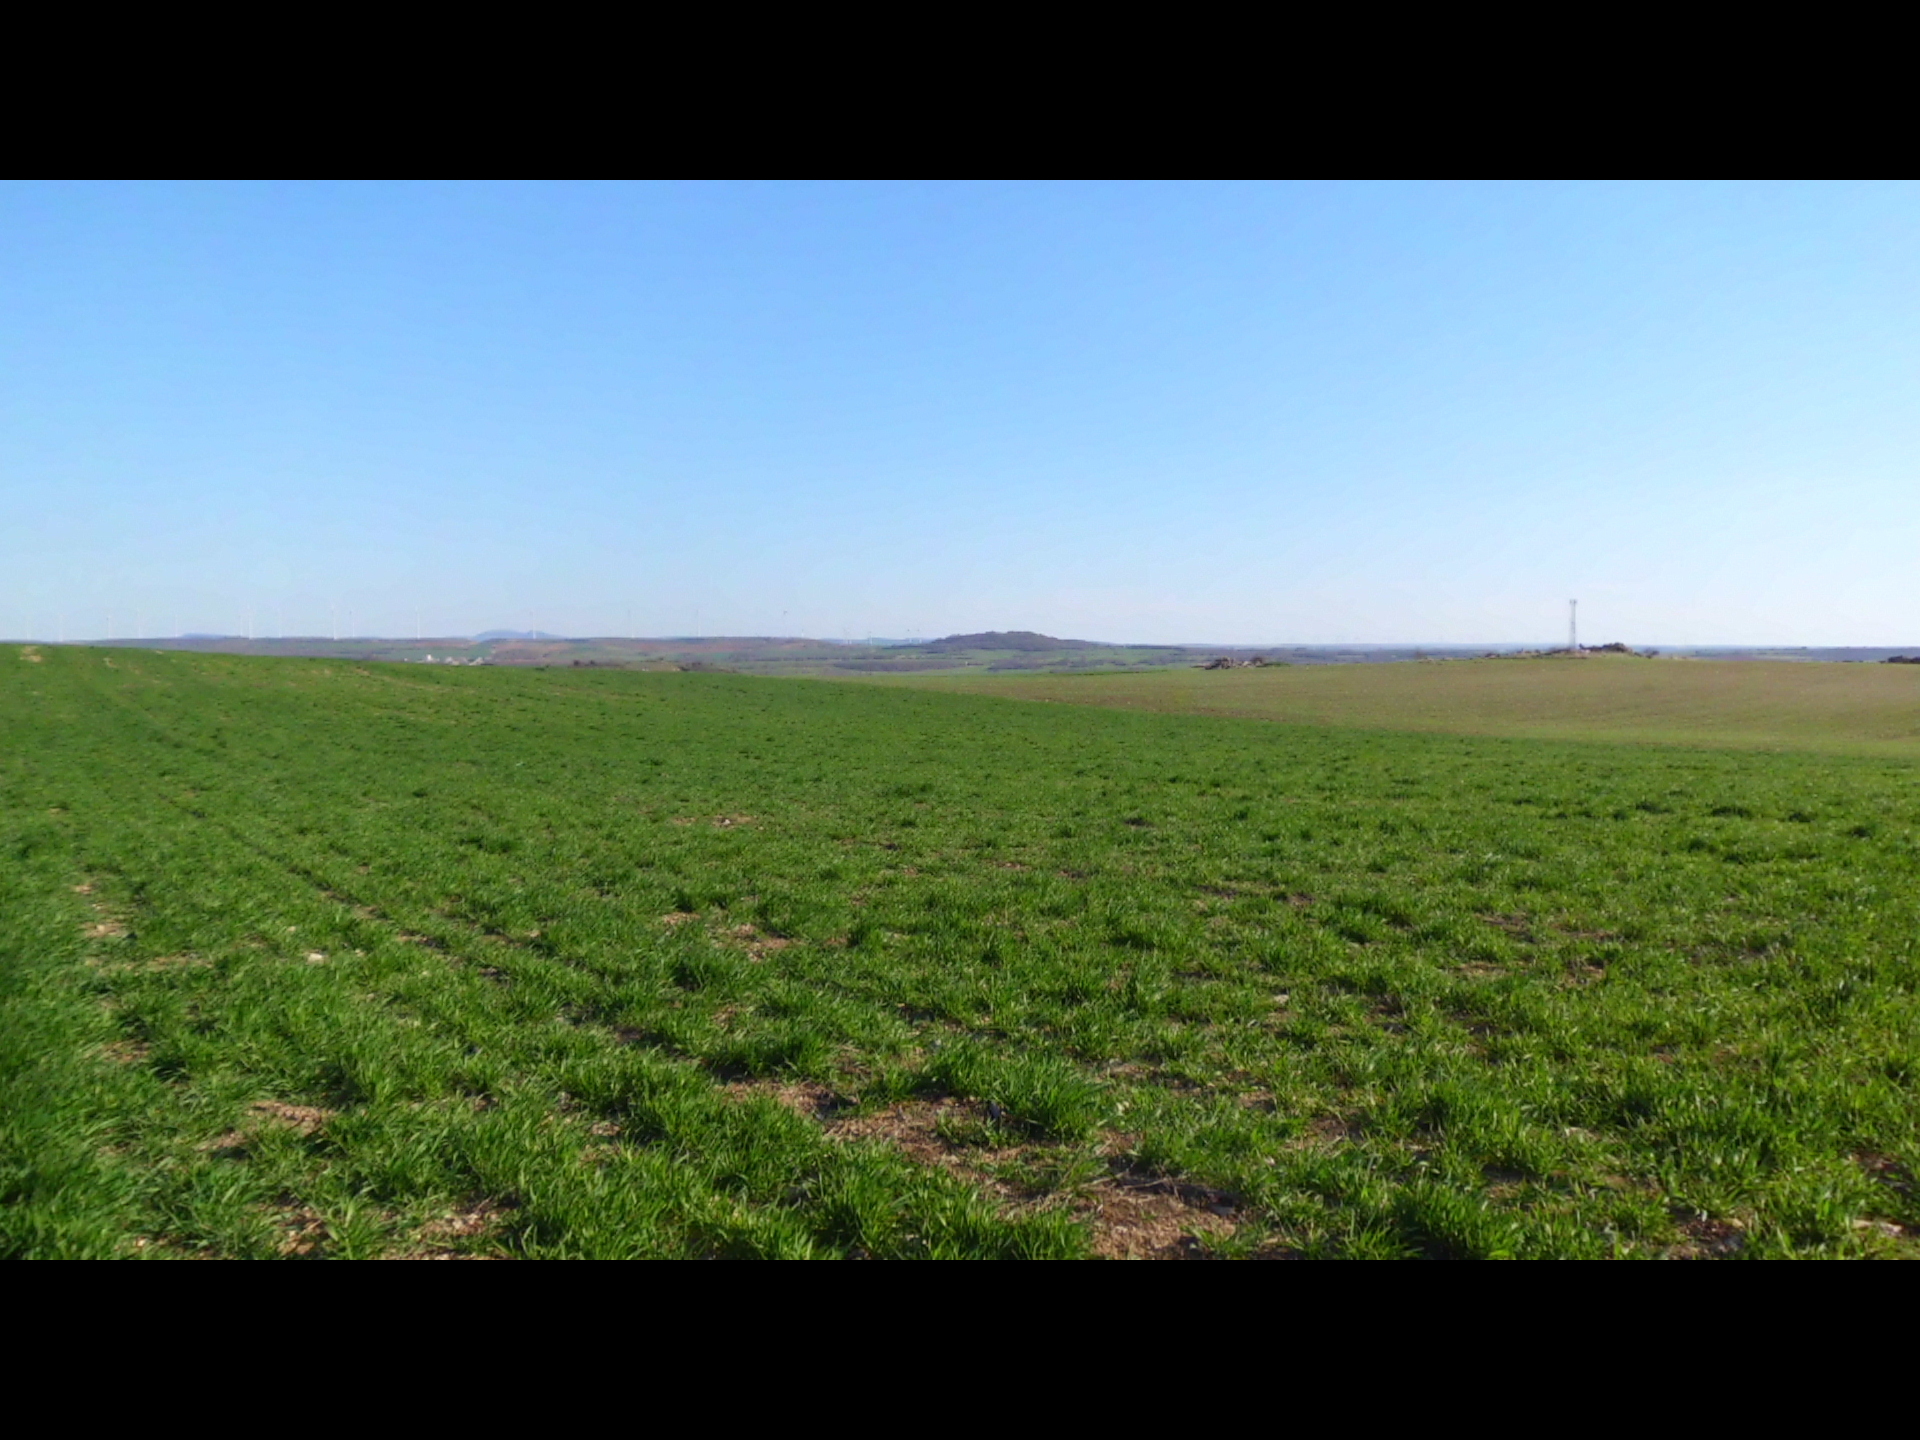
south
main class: Cropland
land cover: Barley
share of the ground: > 75 %
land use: Agriculture (excluding fallow land and kitchen gardens)
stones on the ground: < 10 %
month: April
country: ES
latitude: 42.3091
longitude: -3.6592
